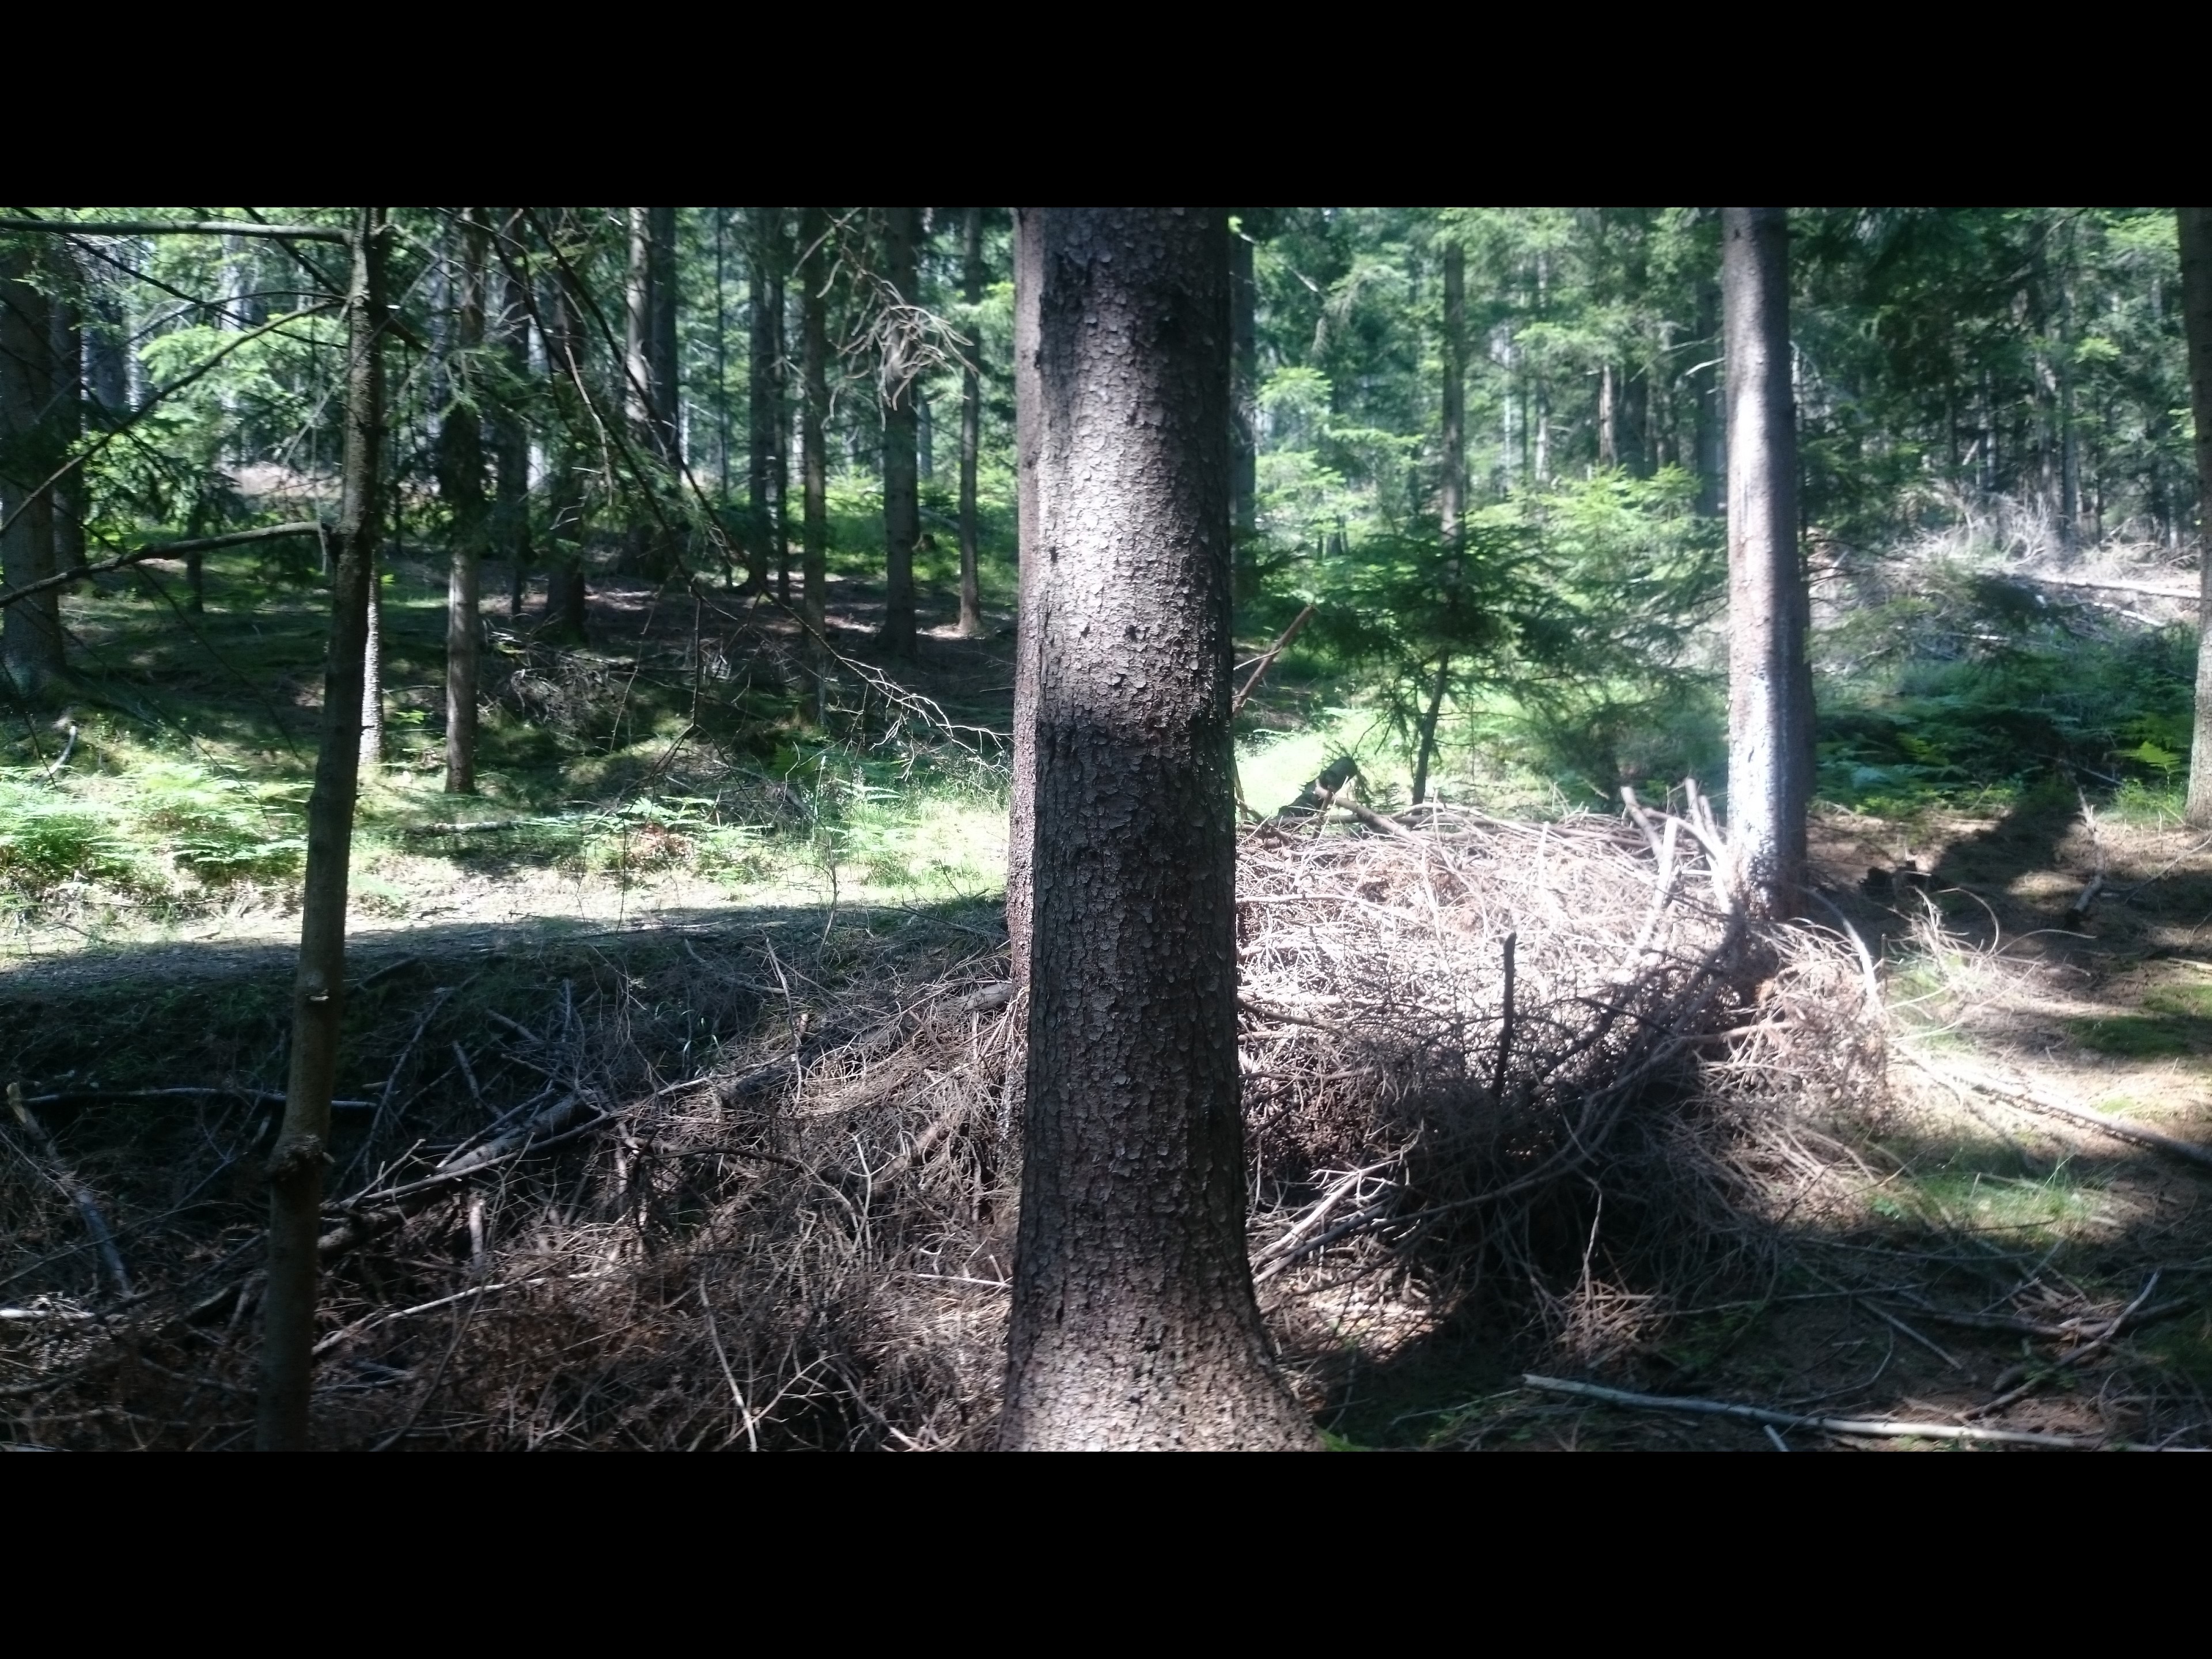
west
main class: Woodland
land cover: Spruce dominated coniferous woodland
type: hemiboreal forest and nemoral coniferous forest and mixed broadleaved-coniferous forest
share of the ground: > 75 %
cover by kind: coniferous forest trees 90 %, consolidated bare surface 10 %
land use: Forestry
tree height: > 5 m
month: July
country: AT
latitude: 47.2021
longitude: 15.5051
